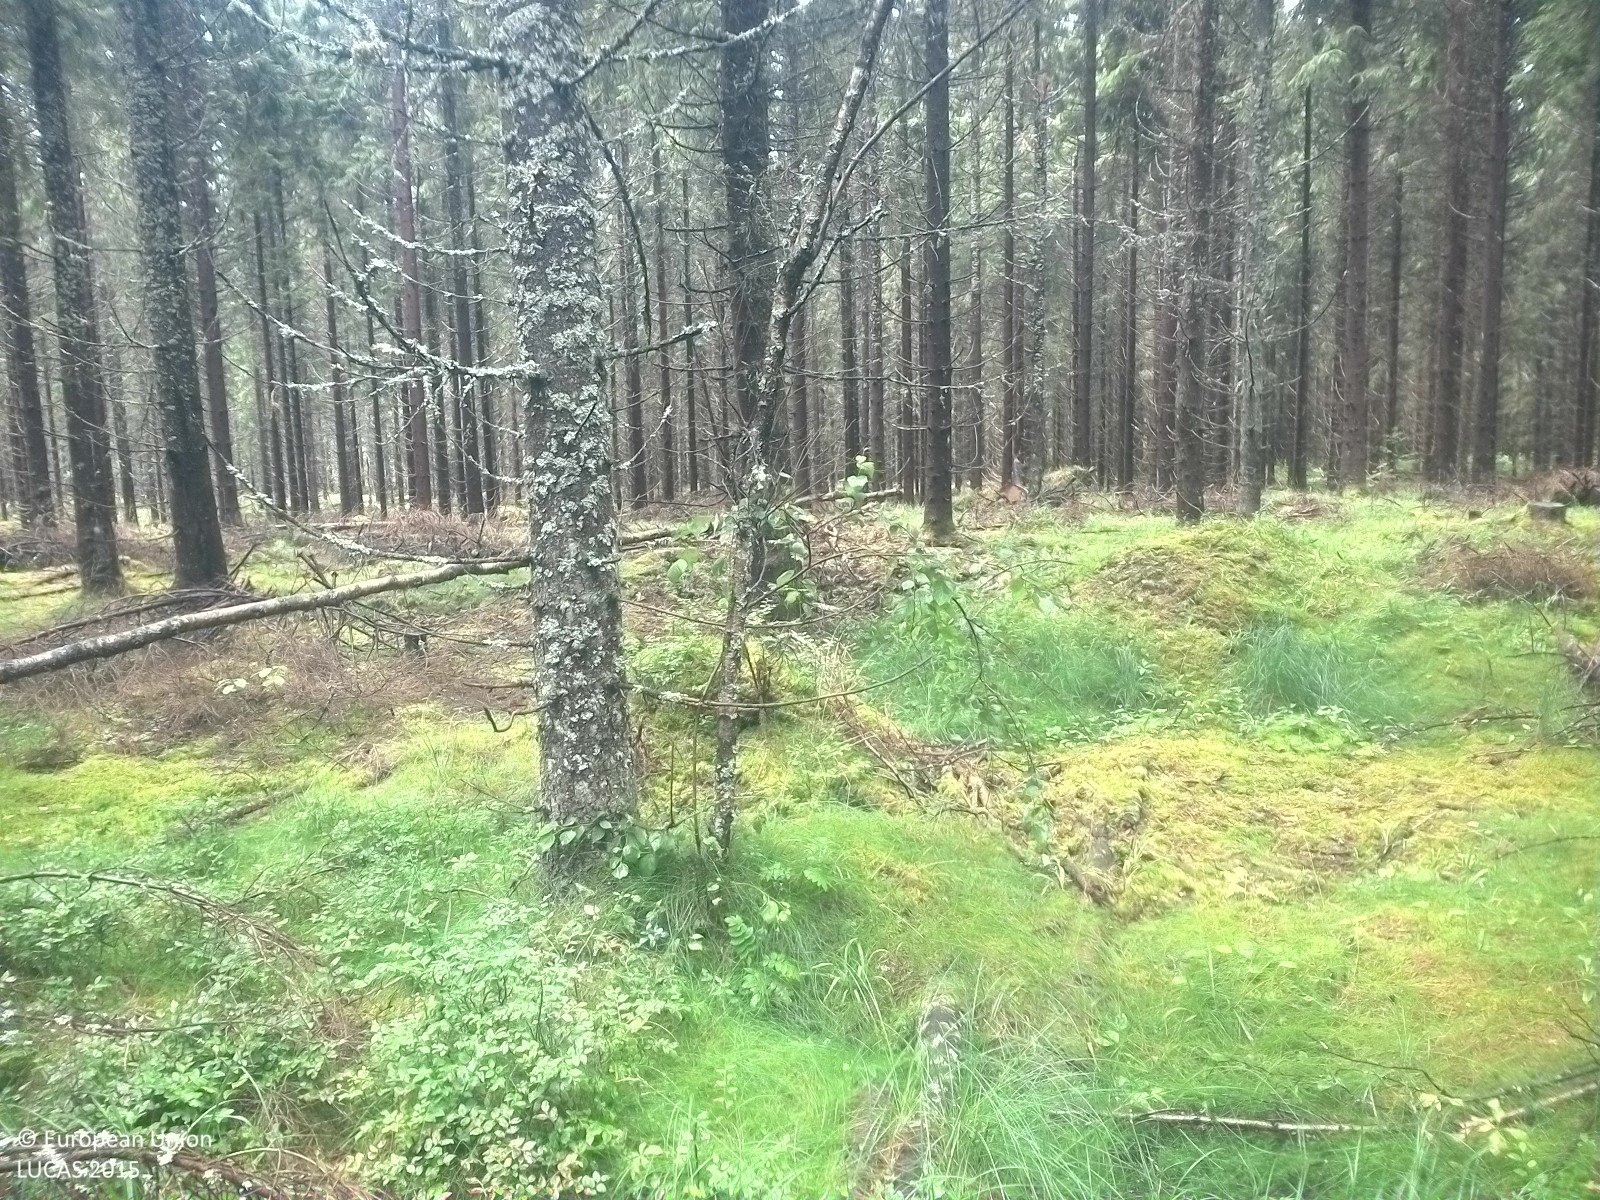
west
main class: Woodland
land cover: Spruce dominated coniferous woodland
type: boreal forest
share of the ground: 25 - 50 %
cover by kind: coniferous forest trees 40 %, lichens and mosses 35 %, herbaceous plants 25 %
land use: Forestry
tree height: > 5 m
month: July
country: SE
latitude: 58.8604
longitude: 15.1420
